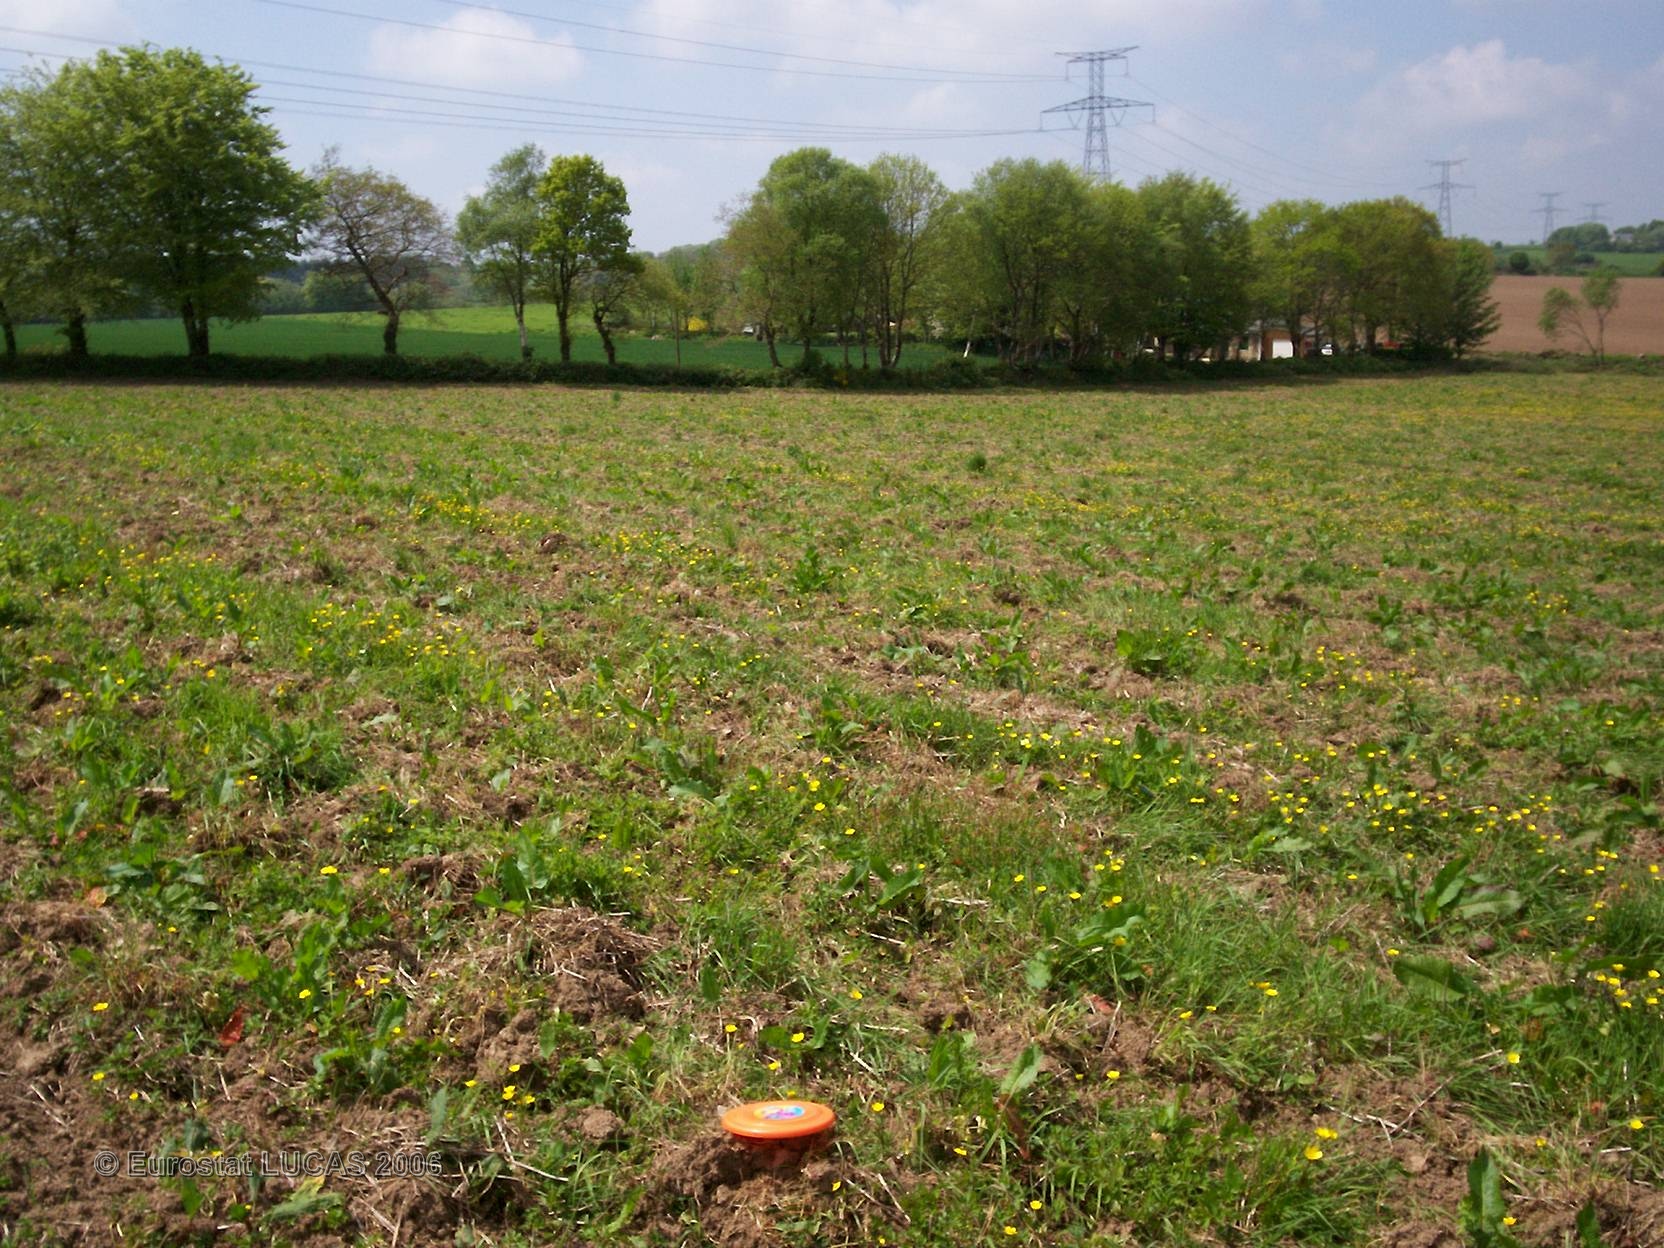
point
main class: Grassland
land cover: Grassland without tree/shrub cover
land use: Fallow land
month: May
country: FR
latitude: 48.1358
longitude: -3.9401
